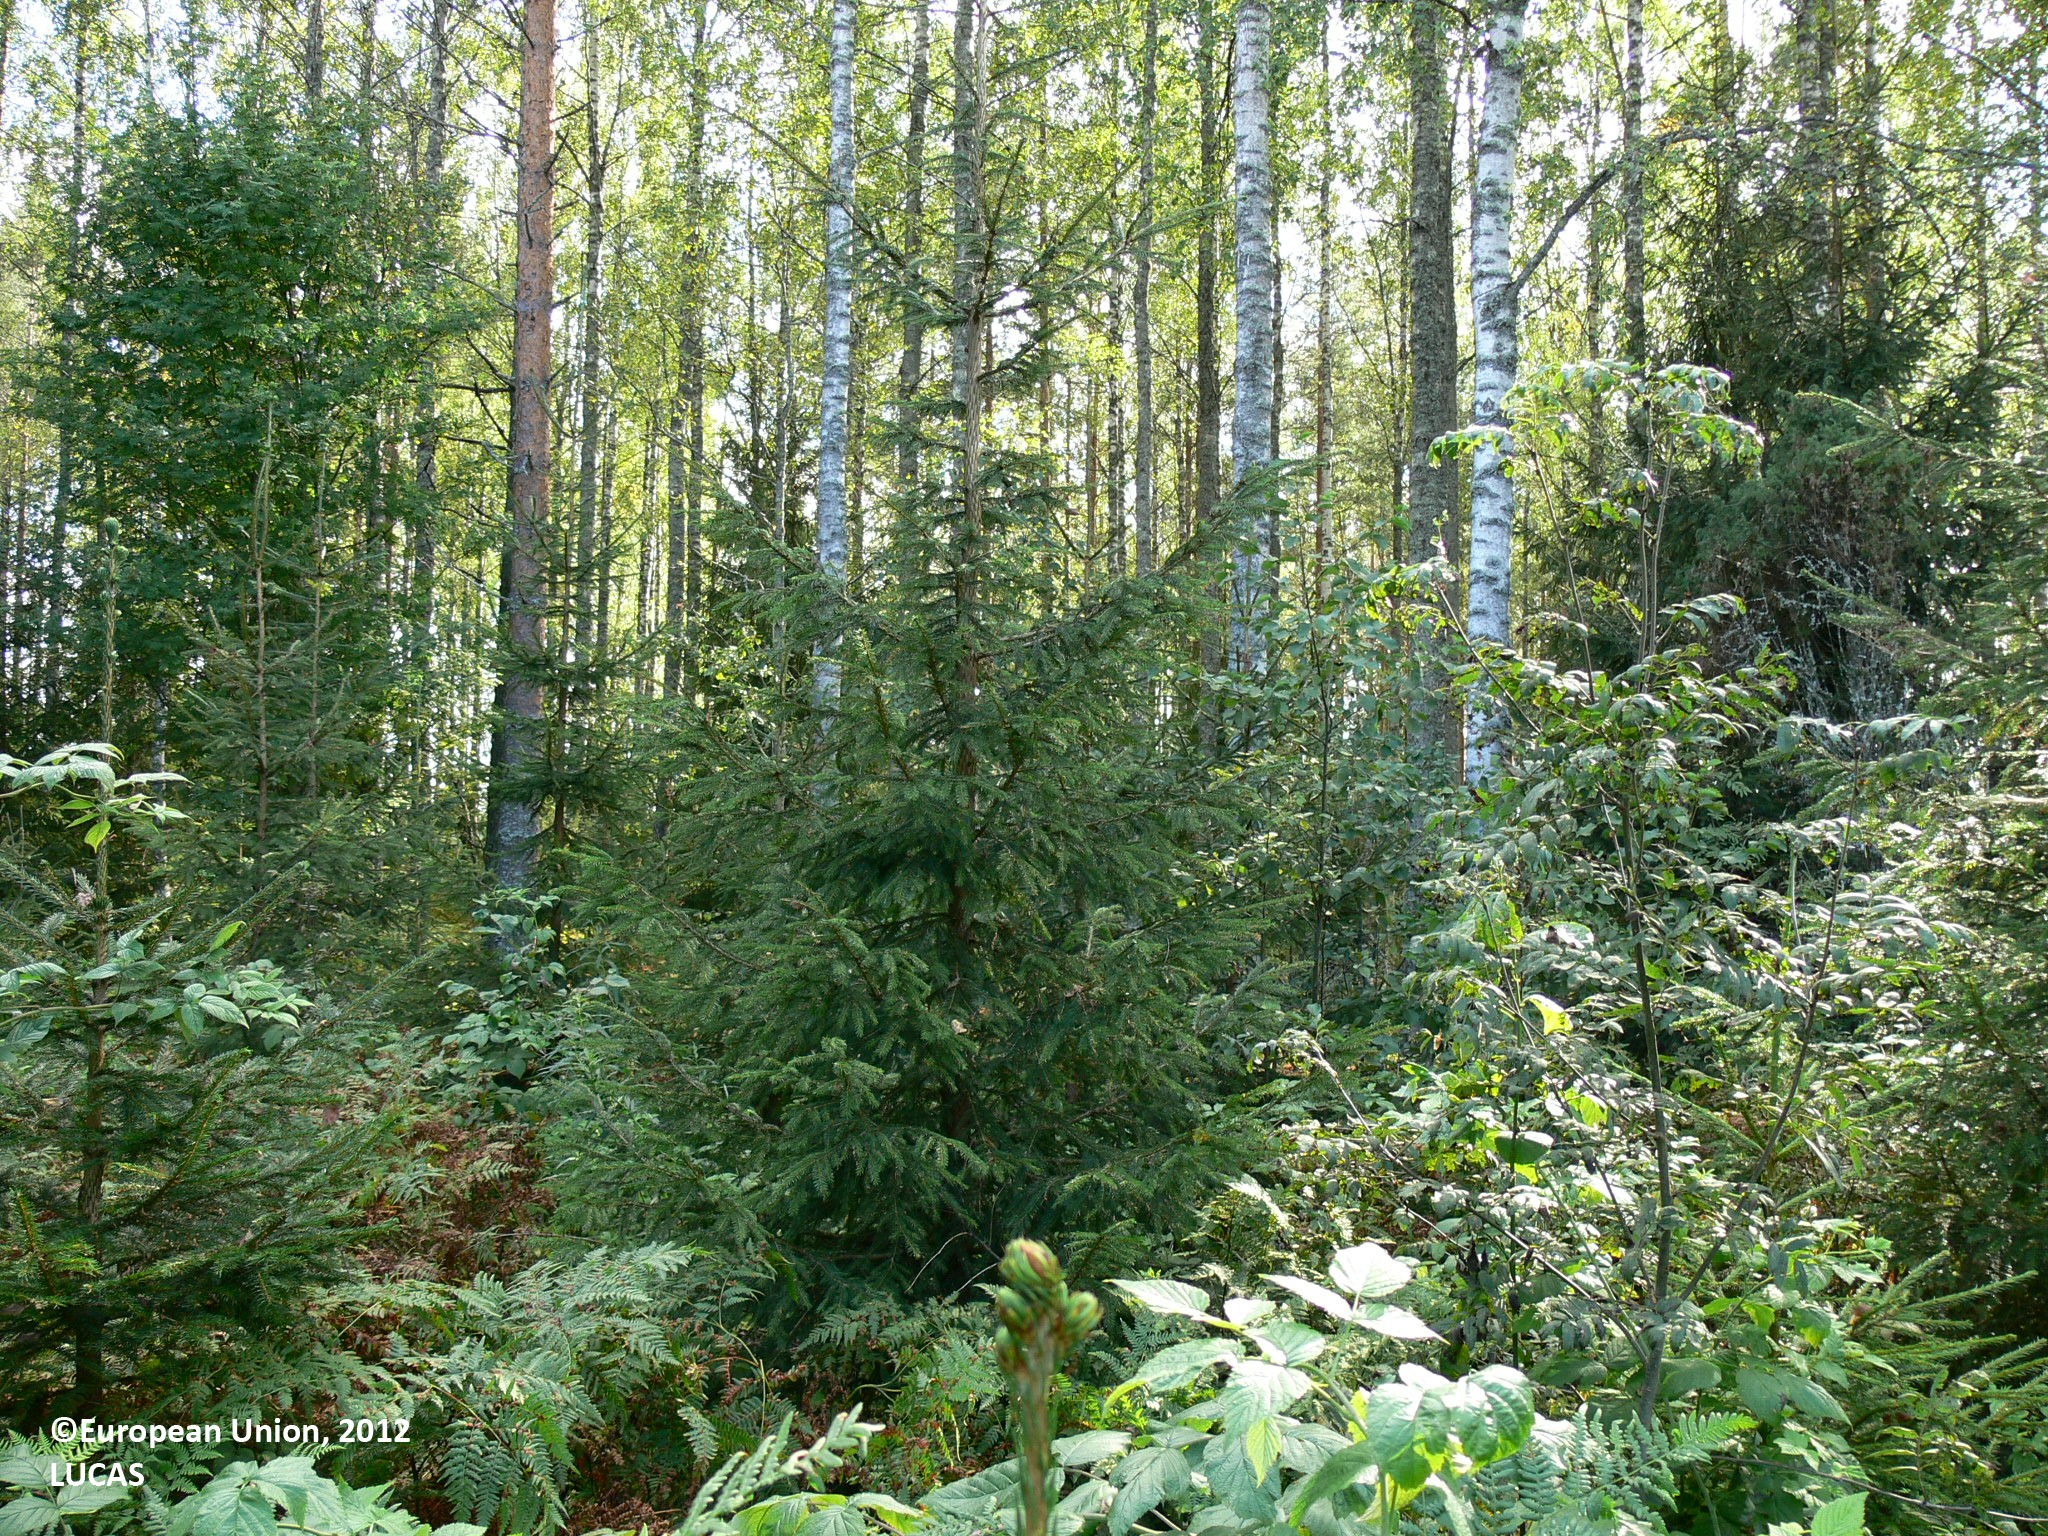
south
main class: Woodland
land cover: Spruce dominated coniferous woodland
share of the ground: 10 - 25 %
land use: Forestry
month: August
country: FI
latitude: 62.0469
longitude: 30.3008
